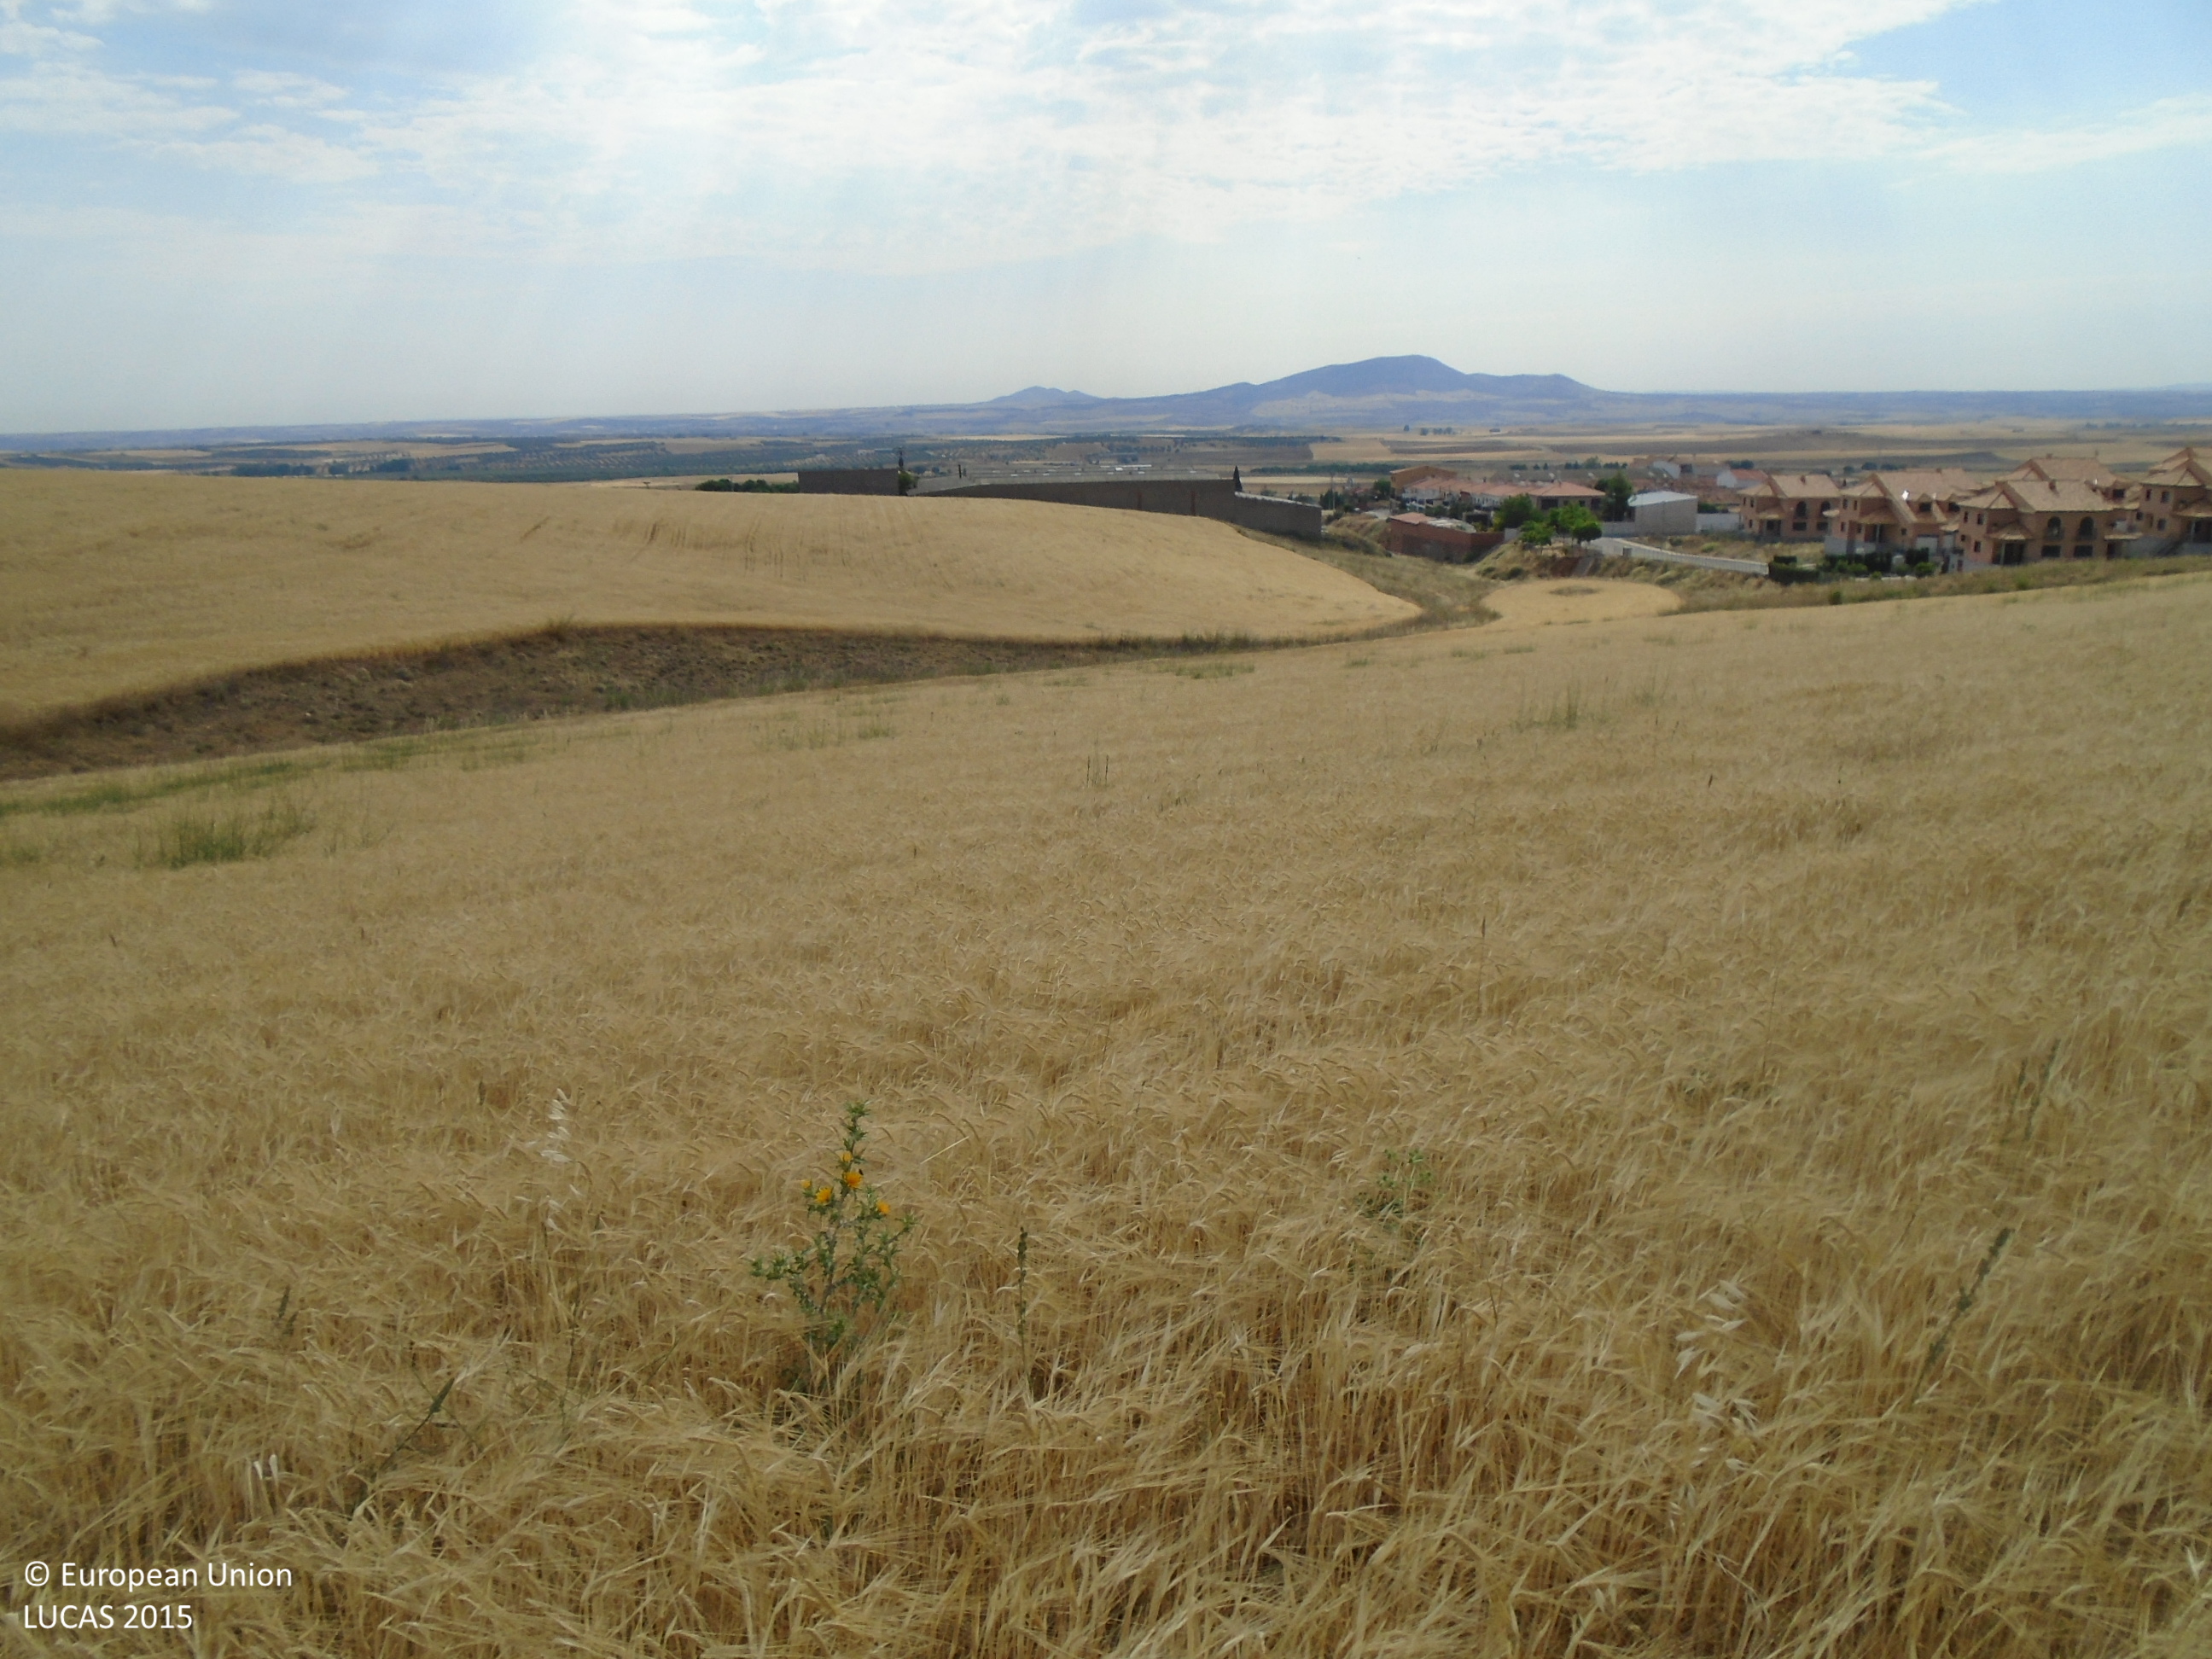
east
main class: Cropland
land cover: Barley
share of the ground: > 75 %
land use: Agriculture (excluding fallow land and kitchen gardens)
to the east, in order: Barley; Grassland with sparse tree/shrub cover; Barley; Grass margins; Artificial constructions in urban areas
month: June
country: ES
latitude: 39.7436
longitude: -4.1904
